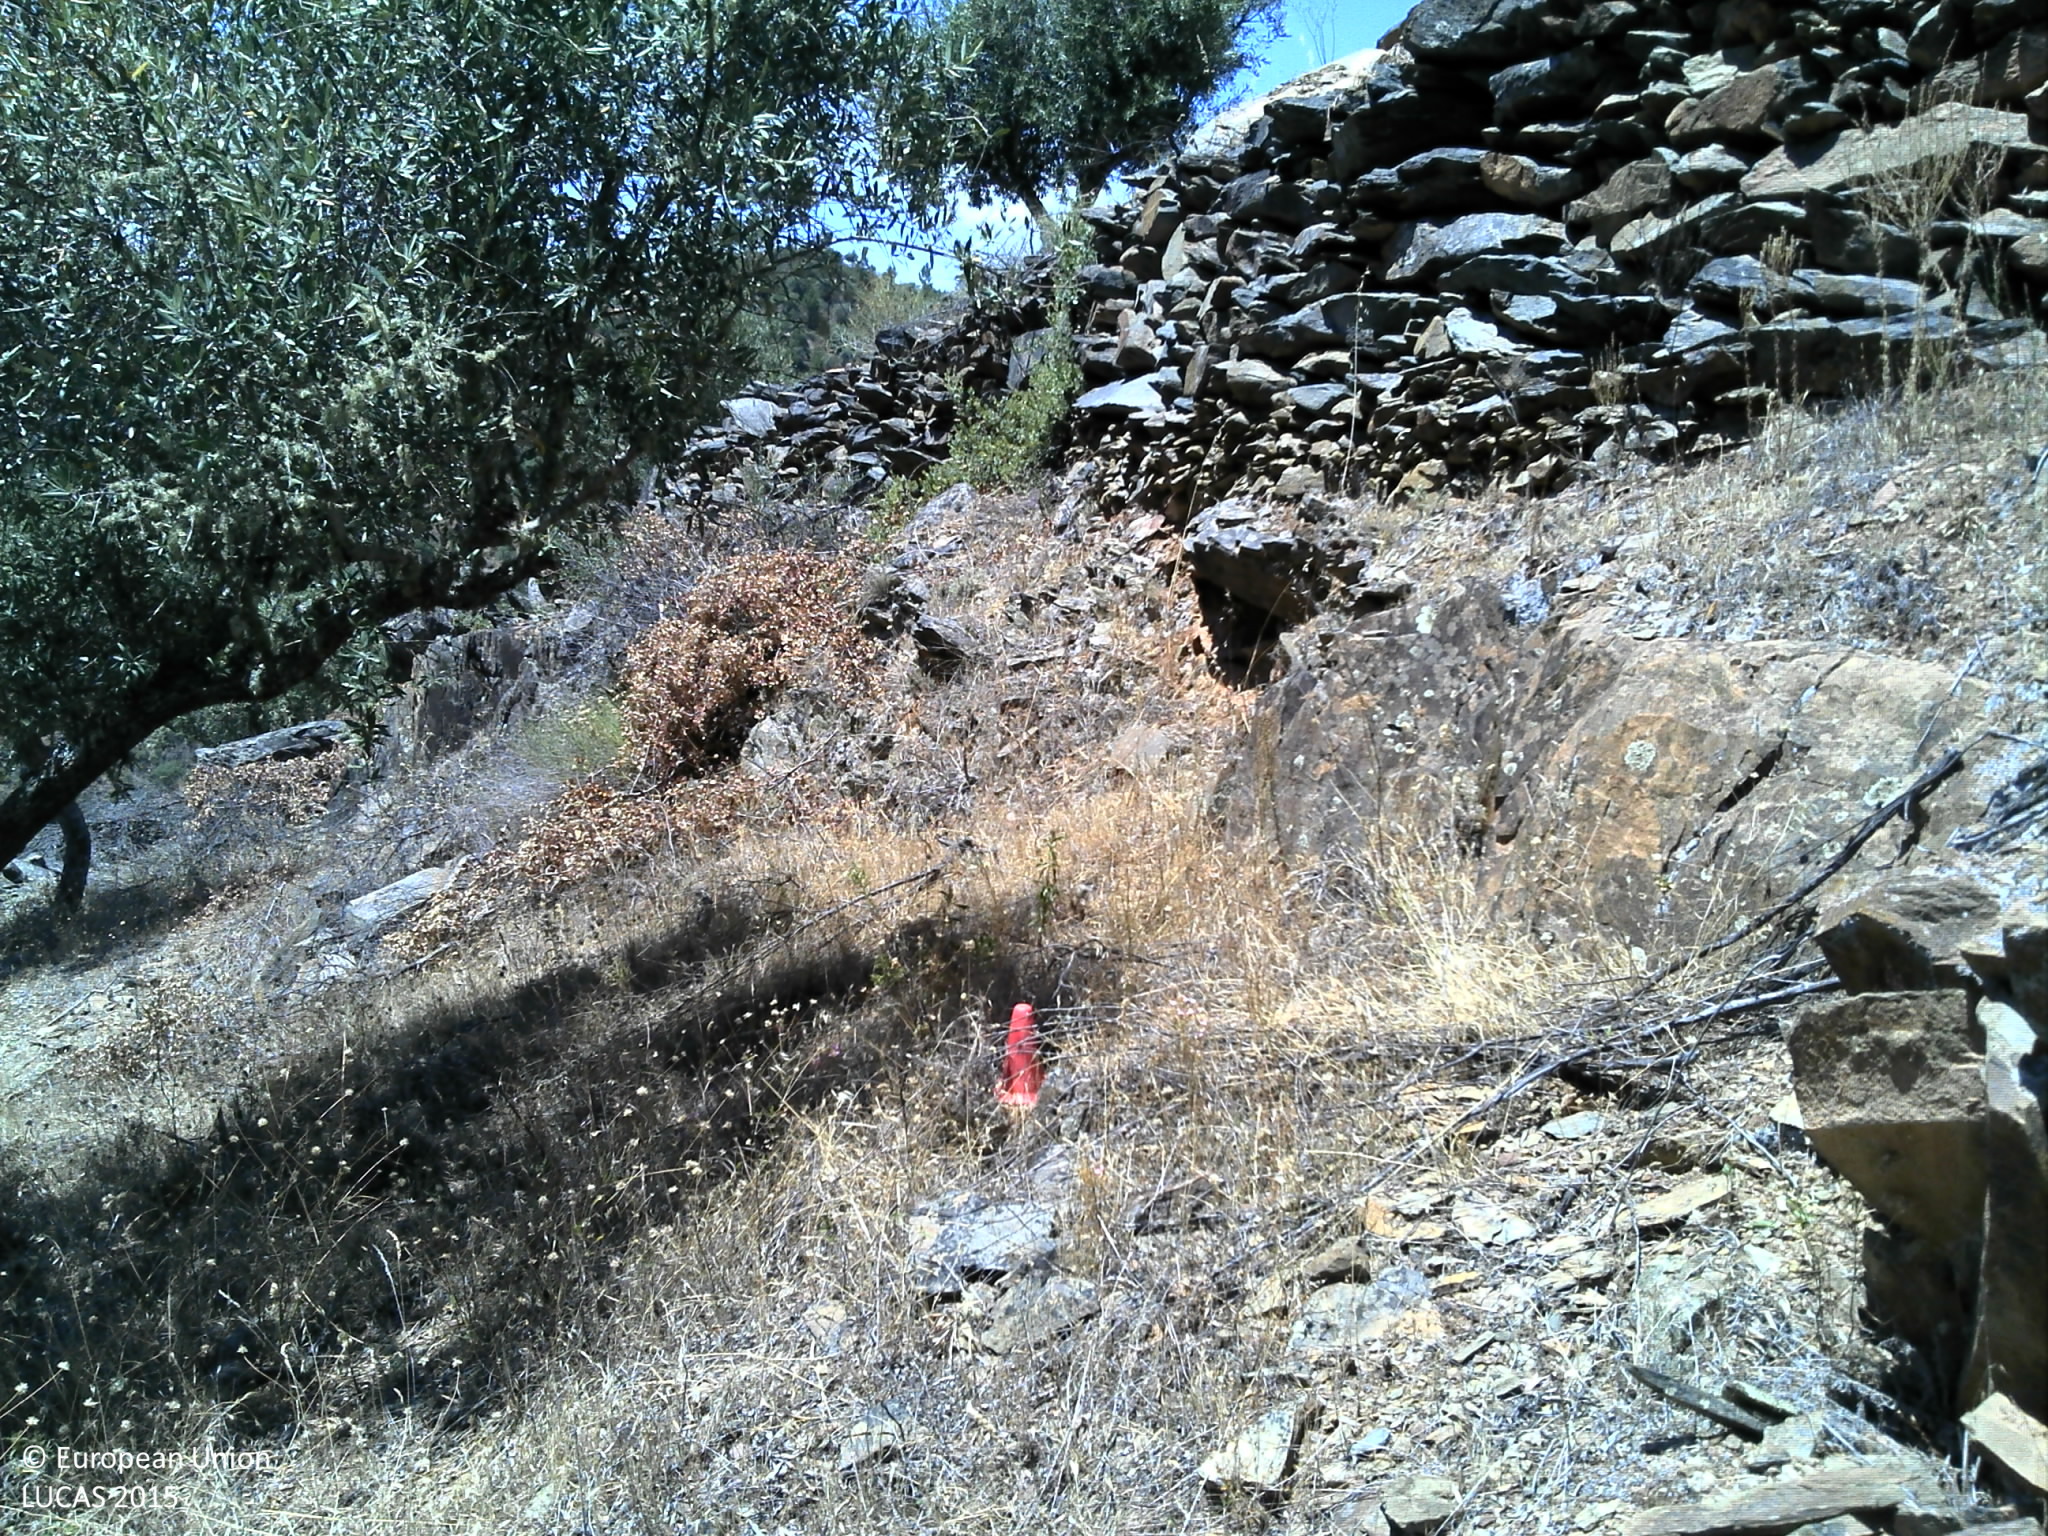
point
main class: Cropland
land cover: Olive groves
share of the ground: 10 - 25 %
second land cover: Grassland without tree/shrub cover
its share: > 75 %
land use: Agriculture (excluding fallow land and kitchen gardens)
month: July
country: PT
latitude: 39.6619
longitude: -7.7855
